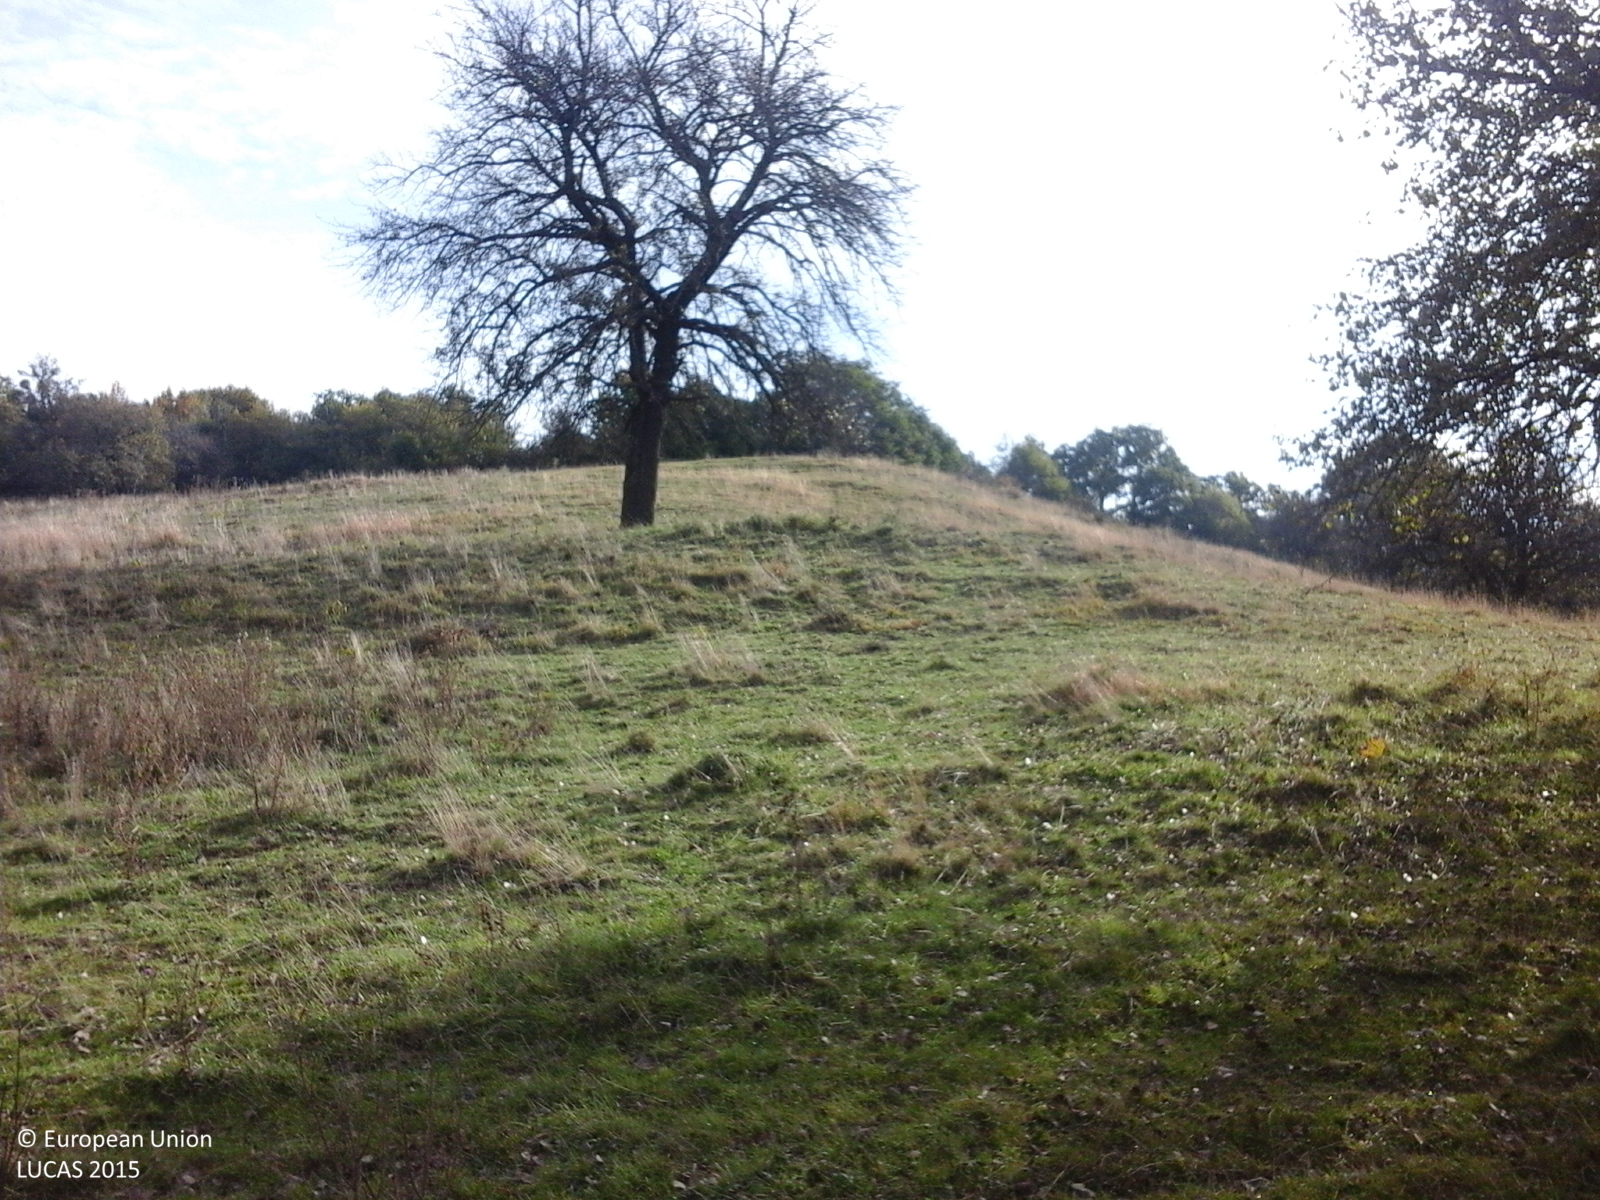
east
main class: Cropland
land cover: Pear fruit
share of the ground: > 75 %
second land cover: Grassland without tree/shrub cover
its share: > 75 %
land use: Agriculture (excluding fallow land and kitchen gardens)
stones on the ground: < 10 %
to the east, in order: Pear fruit; Grassland without tree/shrub cover; Tracks; Pear fruit; Broadleaved woodland
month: October
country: RO
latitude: 46.1779
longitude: 25.1642
